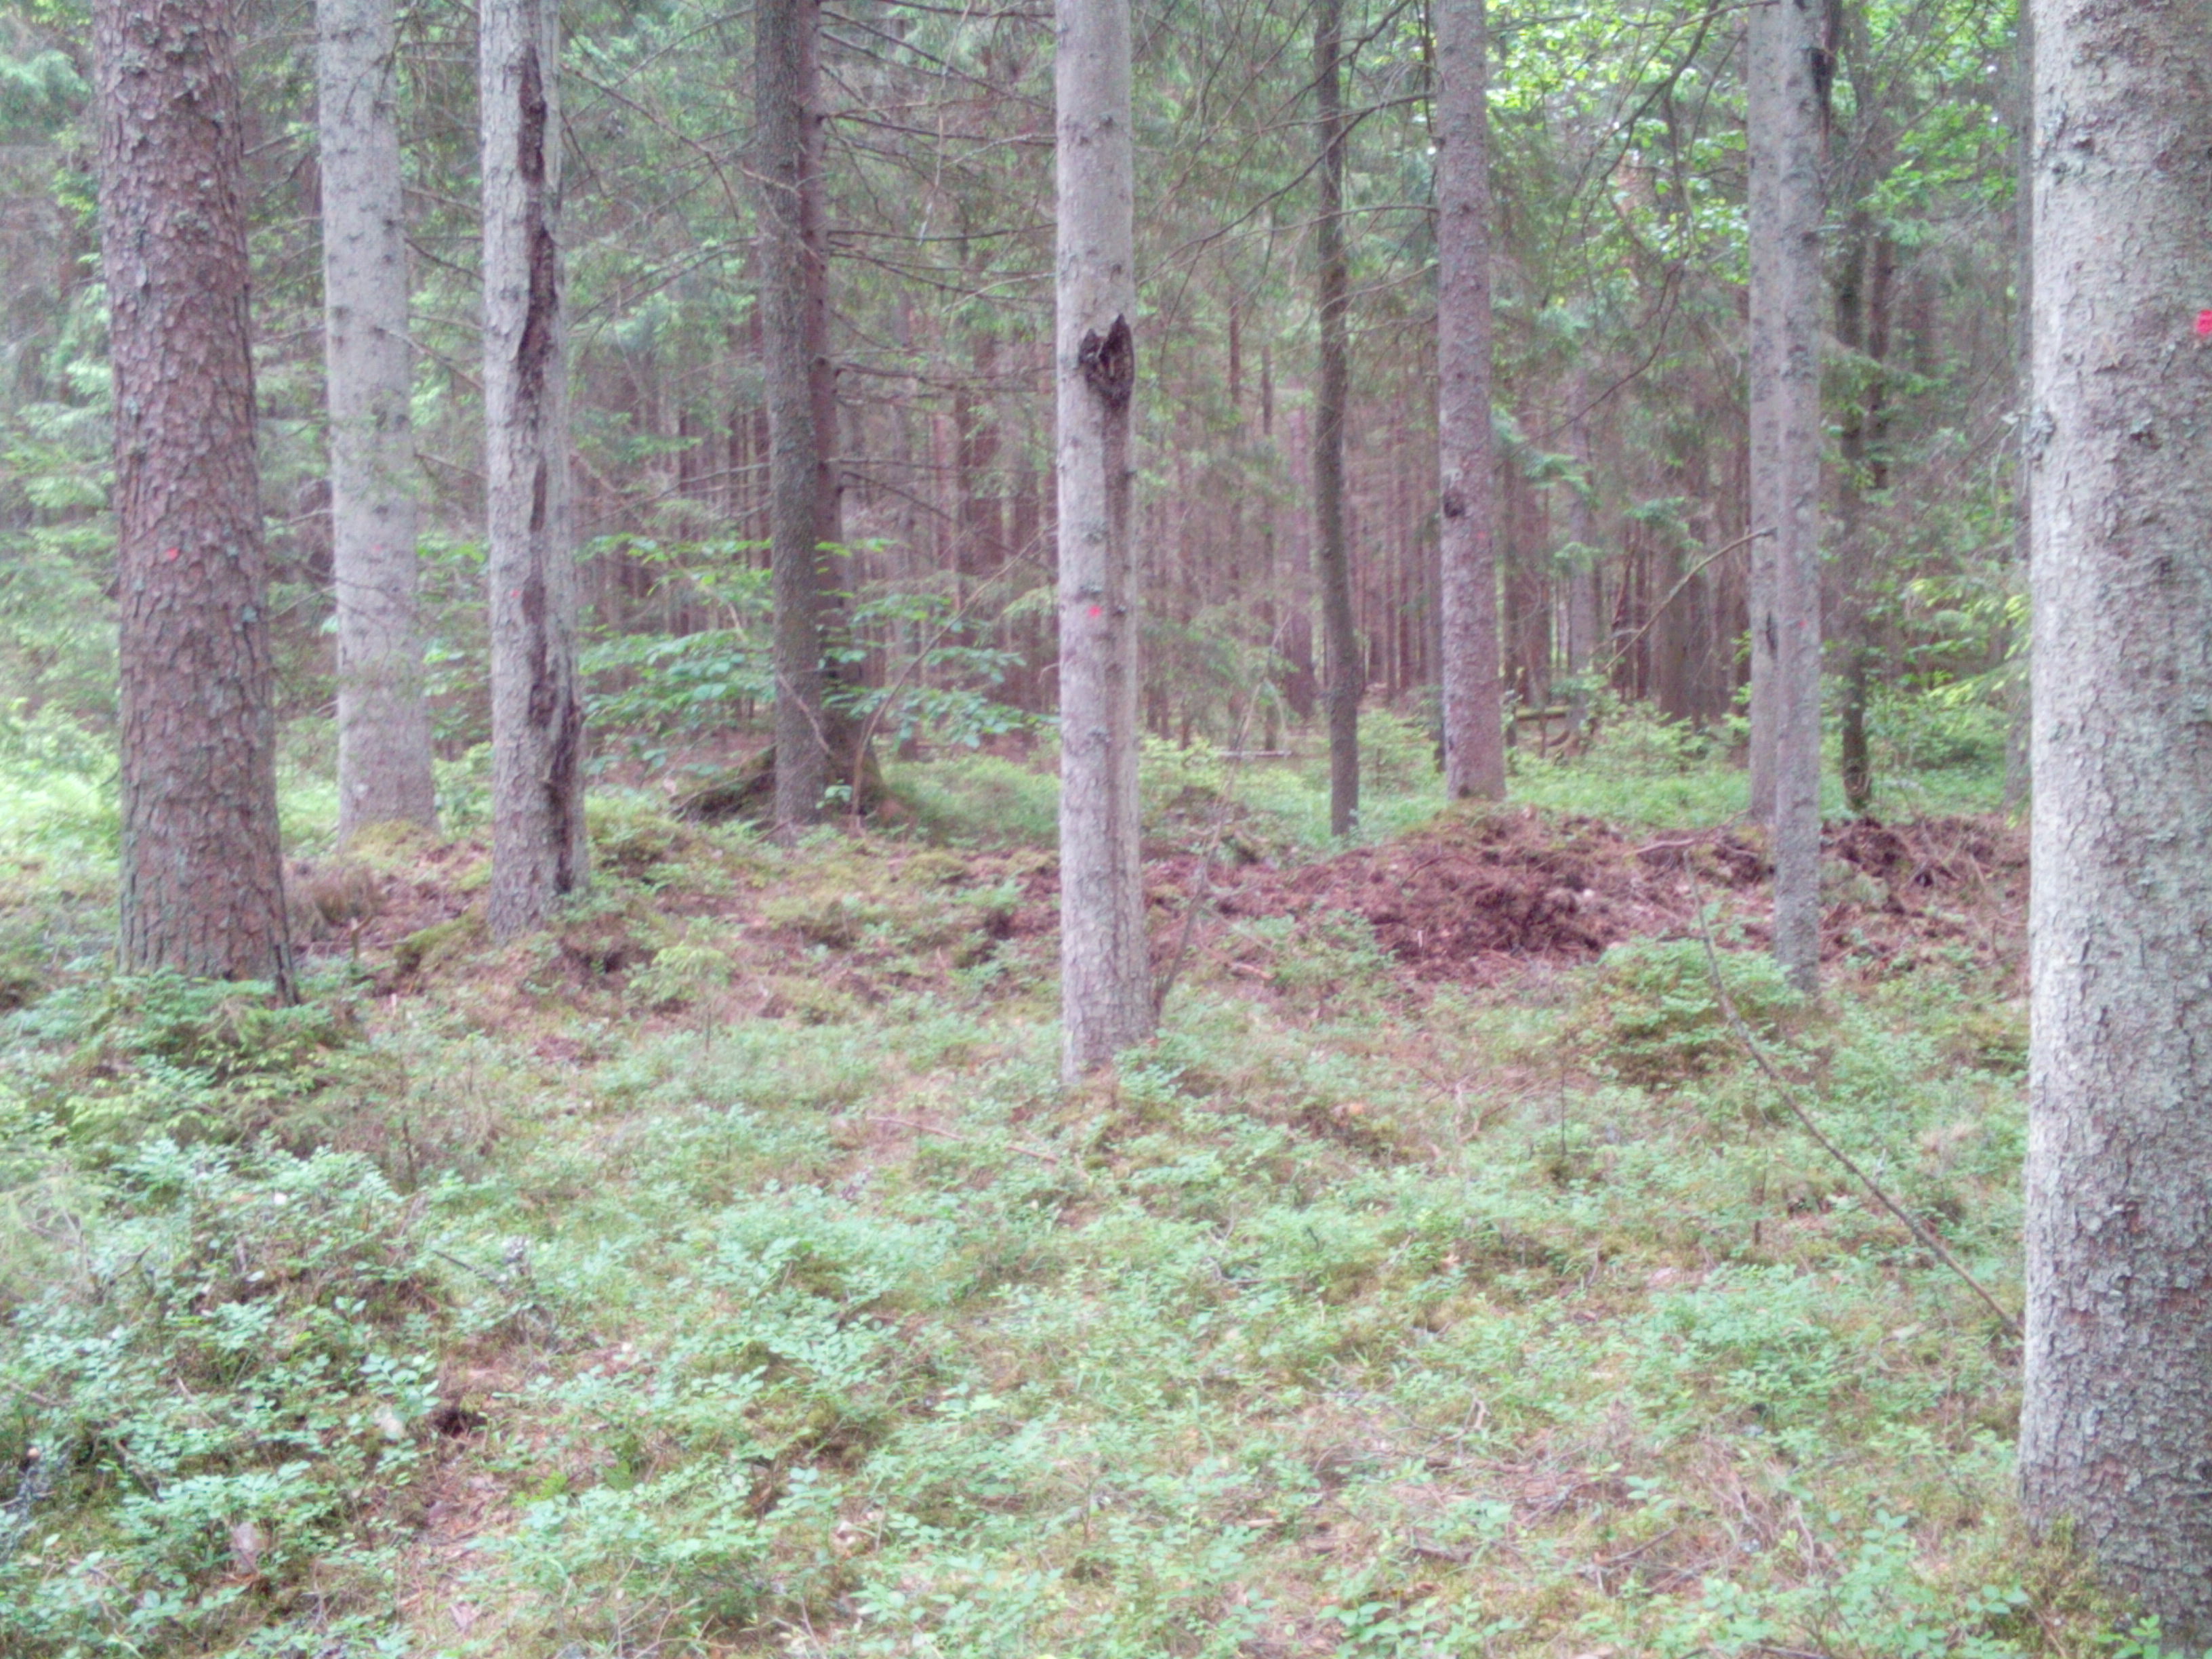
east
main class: Woodland
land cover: Other coniferous woodland
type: hemiboreal forest and nemoral coniferous forest and mixed broadleaved-coniferous forest
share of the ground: > 75 %
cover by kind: coniferous forest trees 85 %, herbaceous plants 10 %, lichens and mosses 5 %
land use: Forestry
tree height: > 5 m
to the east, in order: Other coniferous woodland; Ditches and canals; Other coniferous woodland
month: June
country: LV
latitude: 56.8032
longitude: 21.4215
